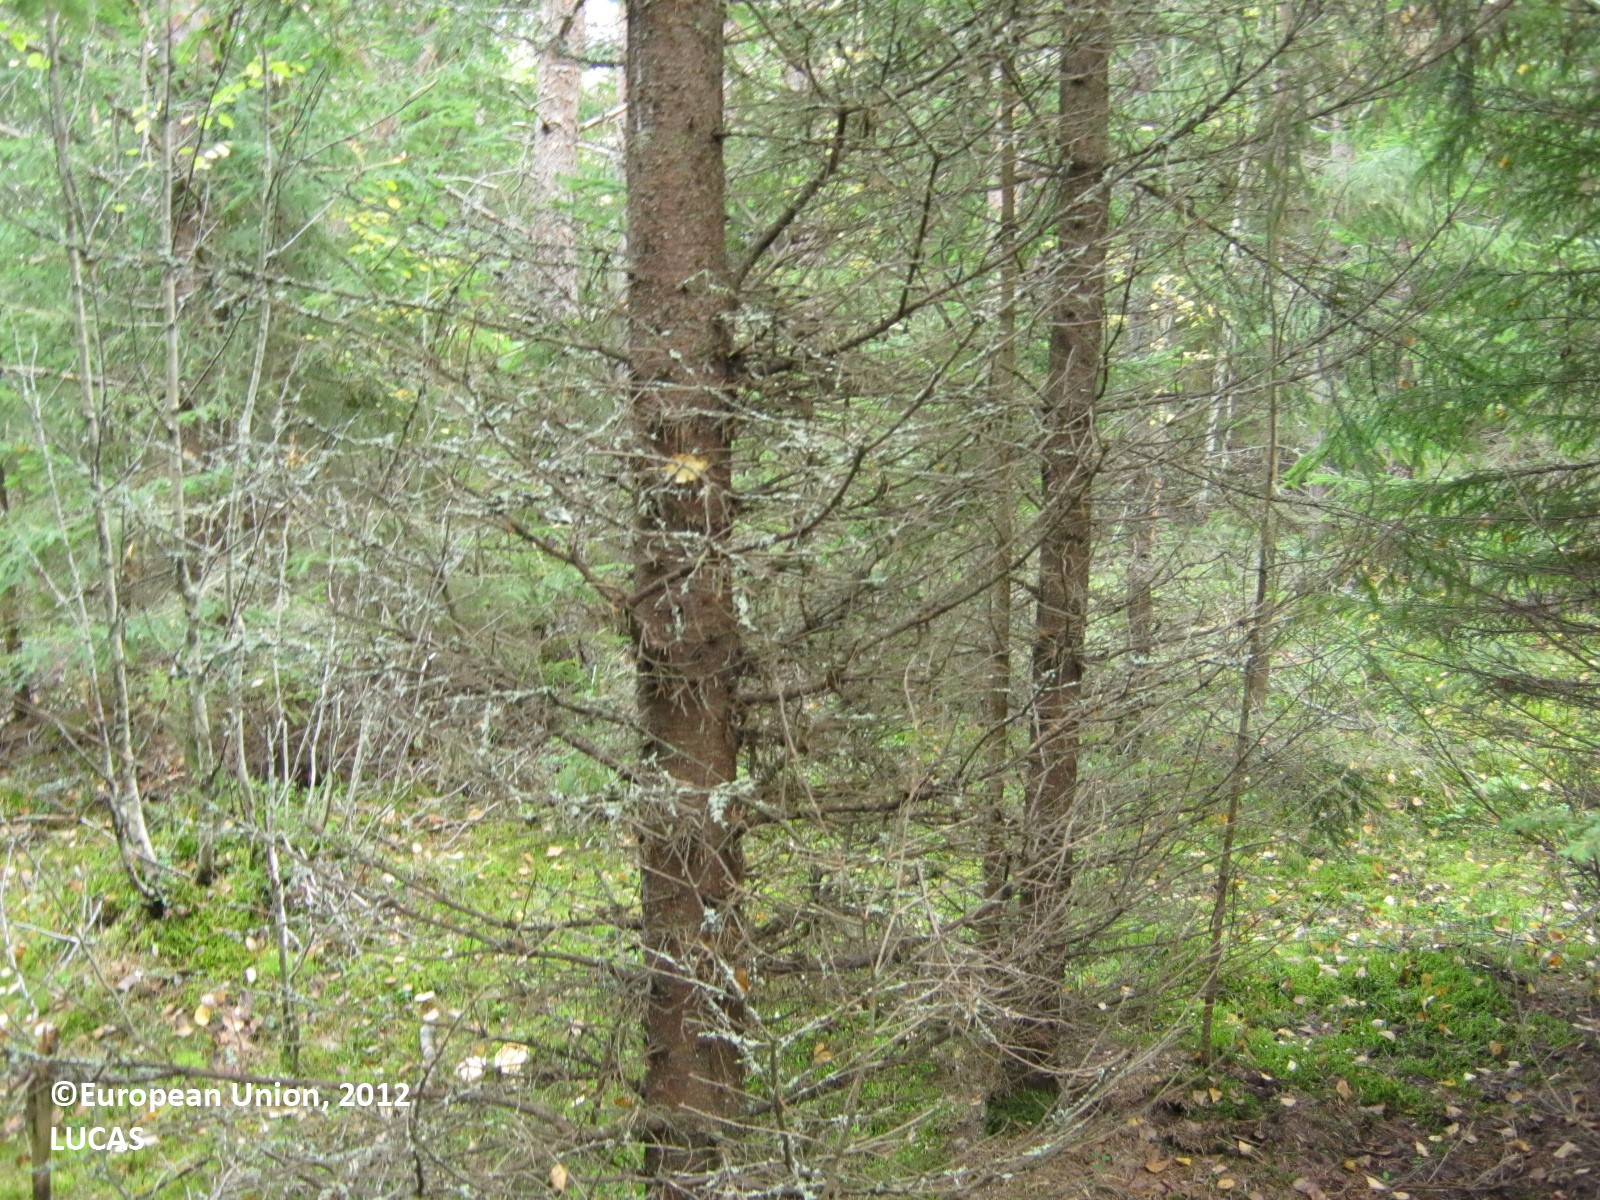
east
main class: Woodland
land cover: Other coniferous woodland
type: boreal forest
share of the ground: > 75 %
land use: Forestry
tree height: > 5 m
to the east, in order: Other coniferous woodland; Spruce dominated coniferous woodland
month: September
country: FI
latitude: 60.7108
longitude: 27.7290
